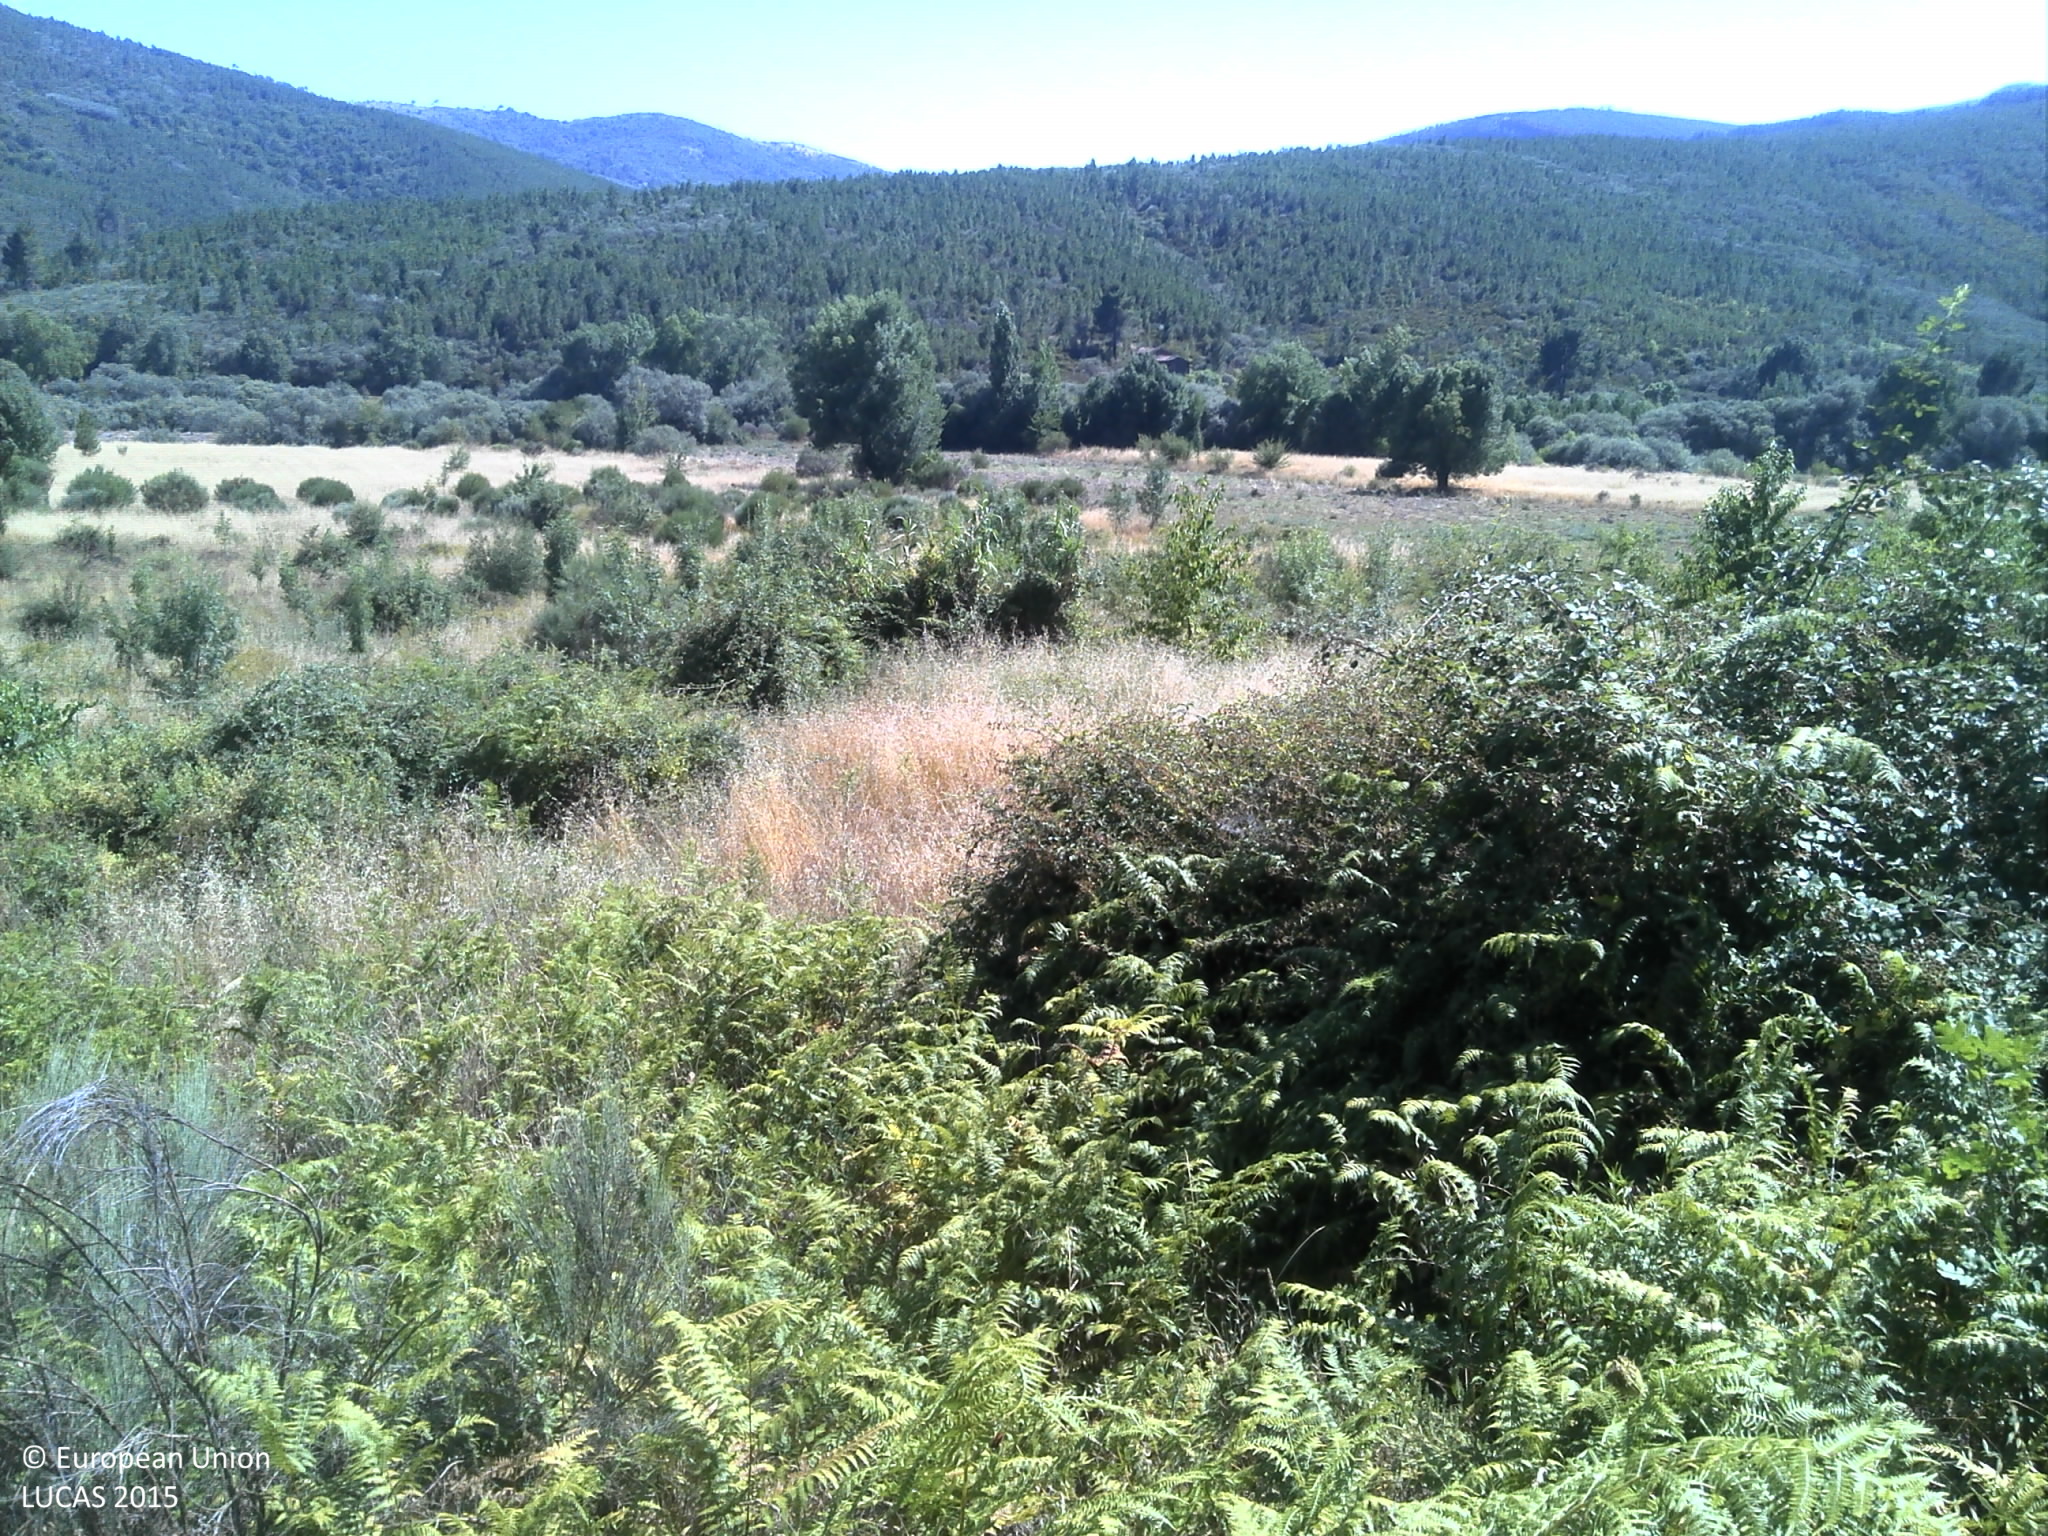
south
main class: Shrubland
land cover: Shrubland with sparse tree cover
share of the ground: 50 - 75 %
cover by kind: shrubs 75 %, unconsolidated bare surface 10 %, coniferous forest trees 5 %, herbaceous plants 5 %
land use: Semi-natural and natural areas not in use
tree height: > 5 m
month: July
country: PT
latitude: 40.3900
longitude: -7.4367
